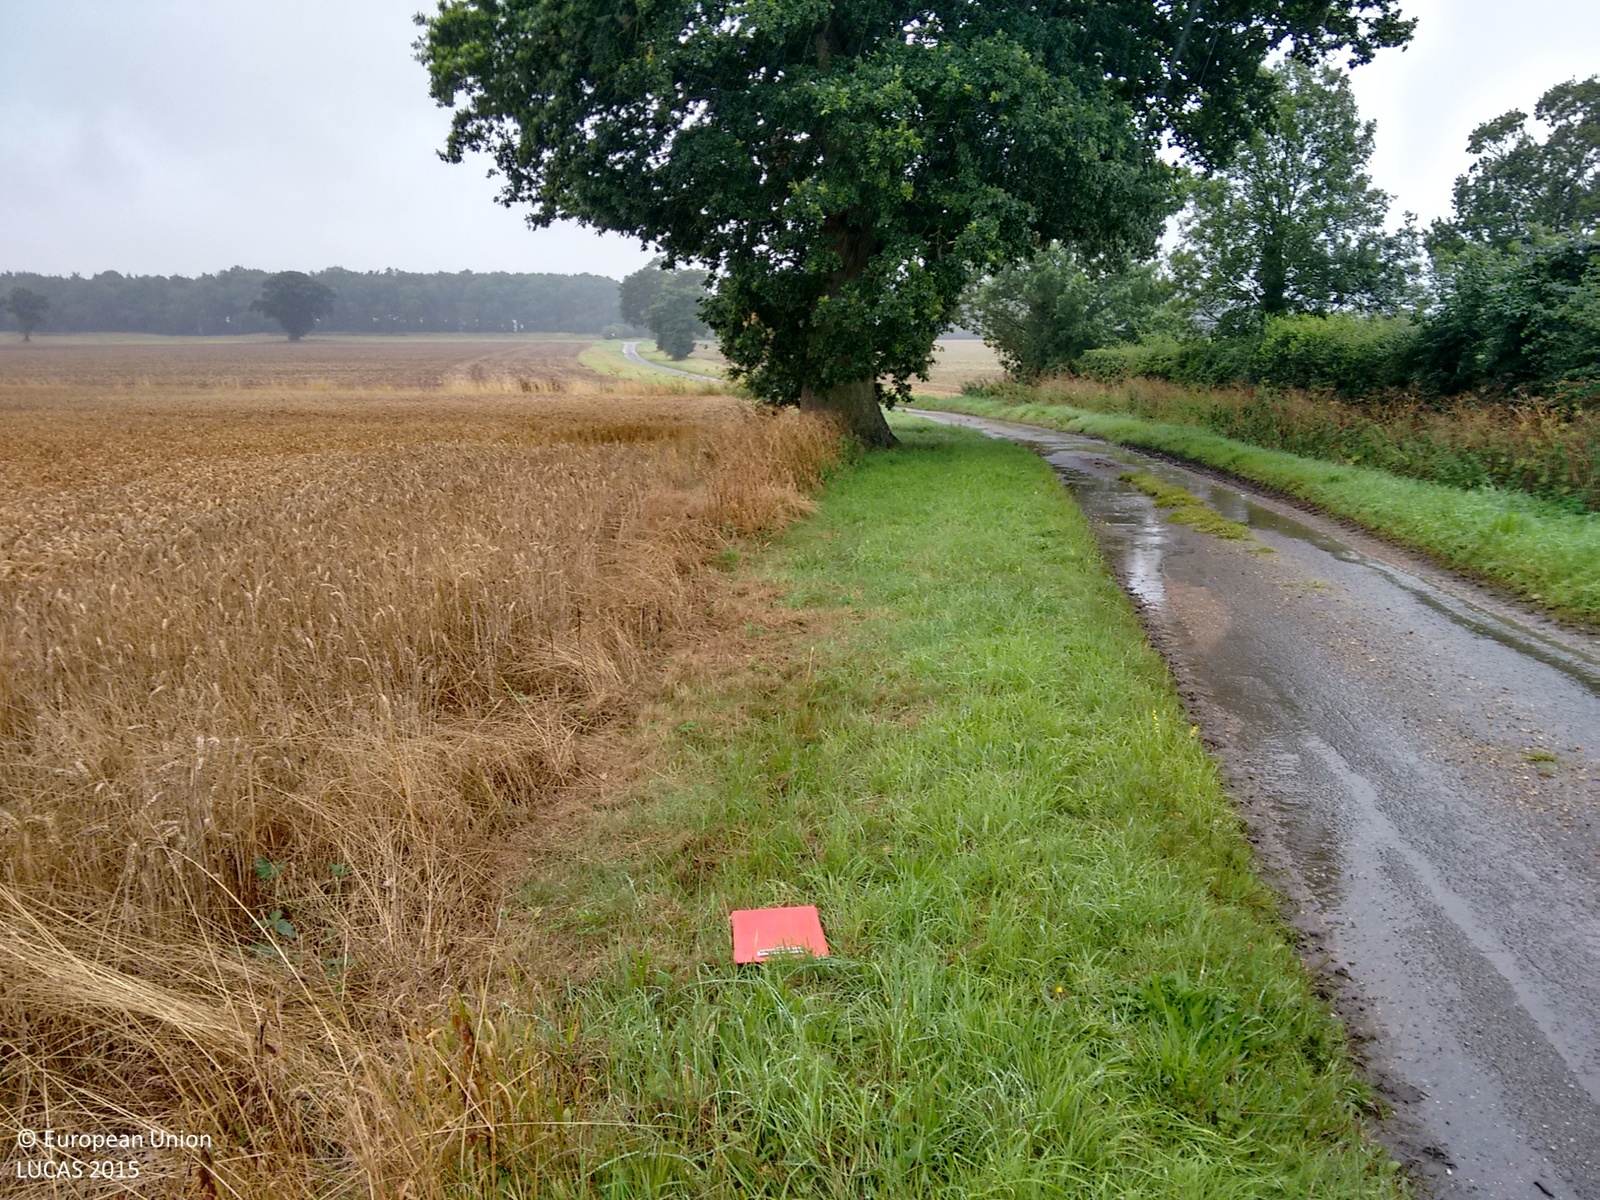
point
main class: Cropland
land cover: Common wheat
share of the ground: > 75 %
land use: Agriculture (excluding fallow land and kitchen gardens)
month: August
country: GB
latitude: 52.8152
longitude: 0.7911
